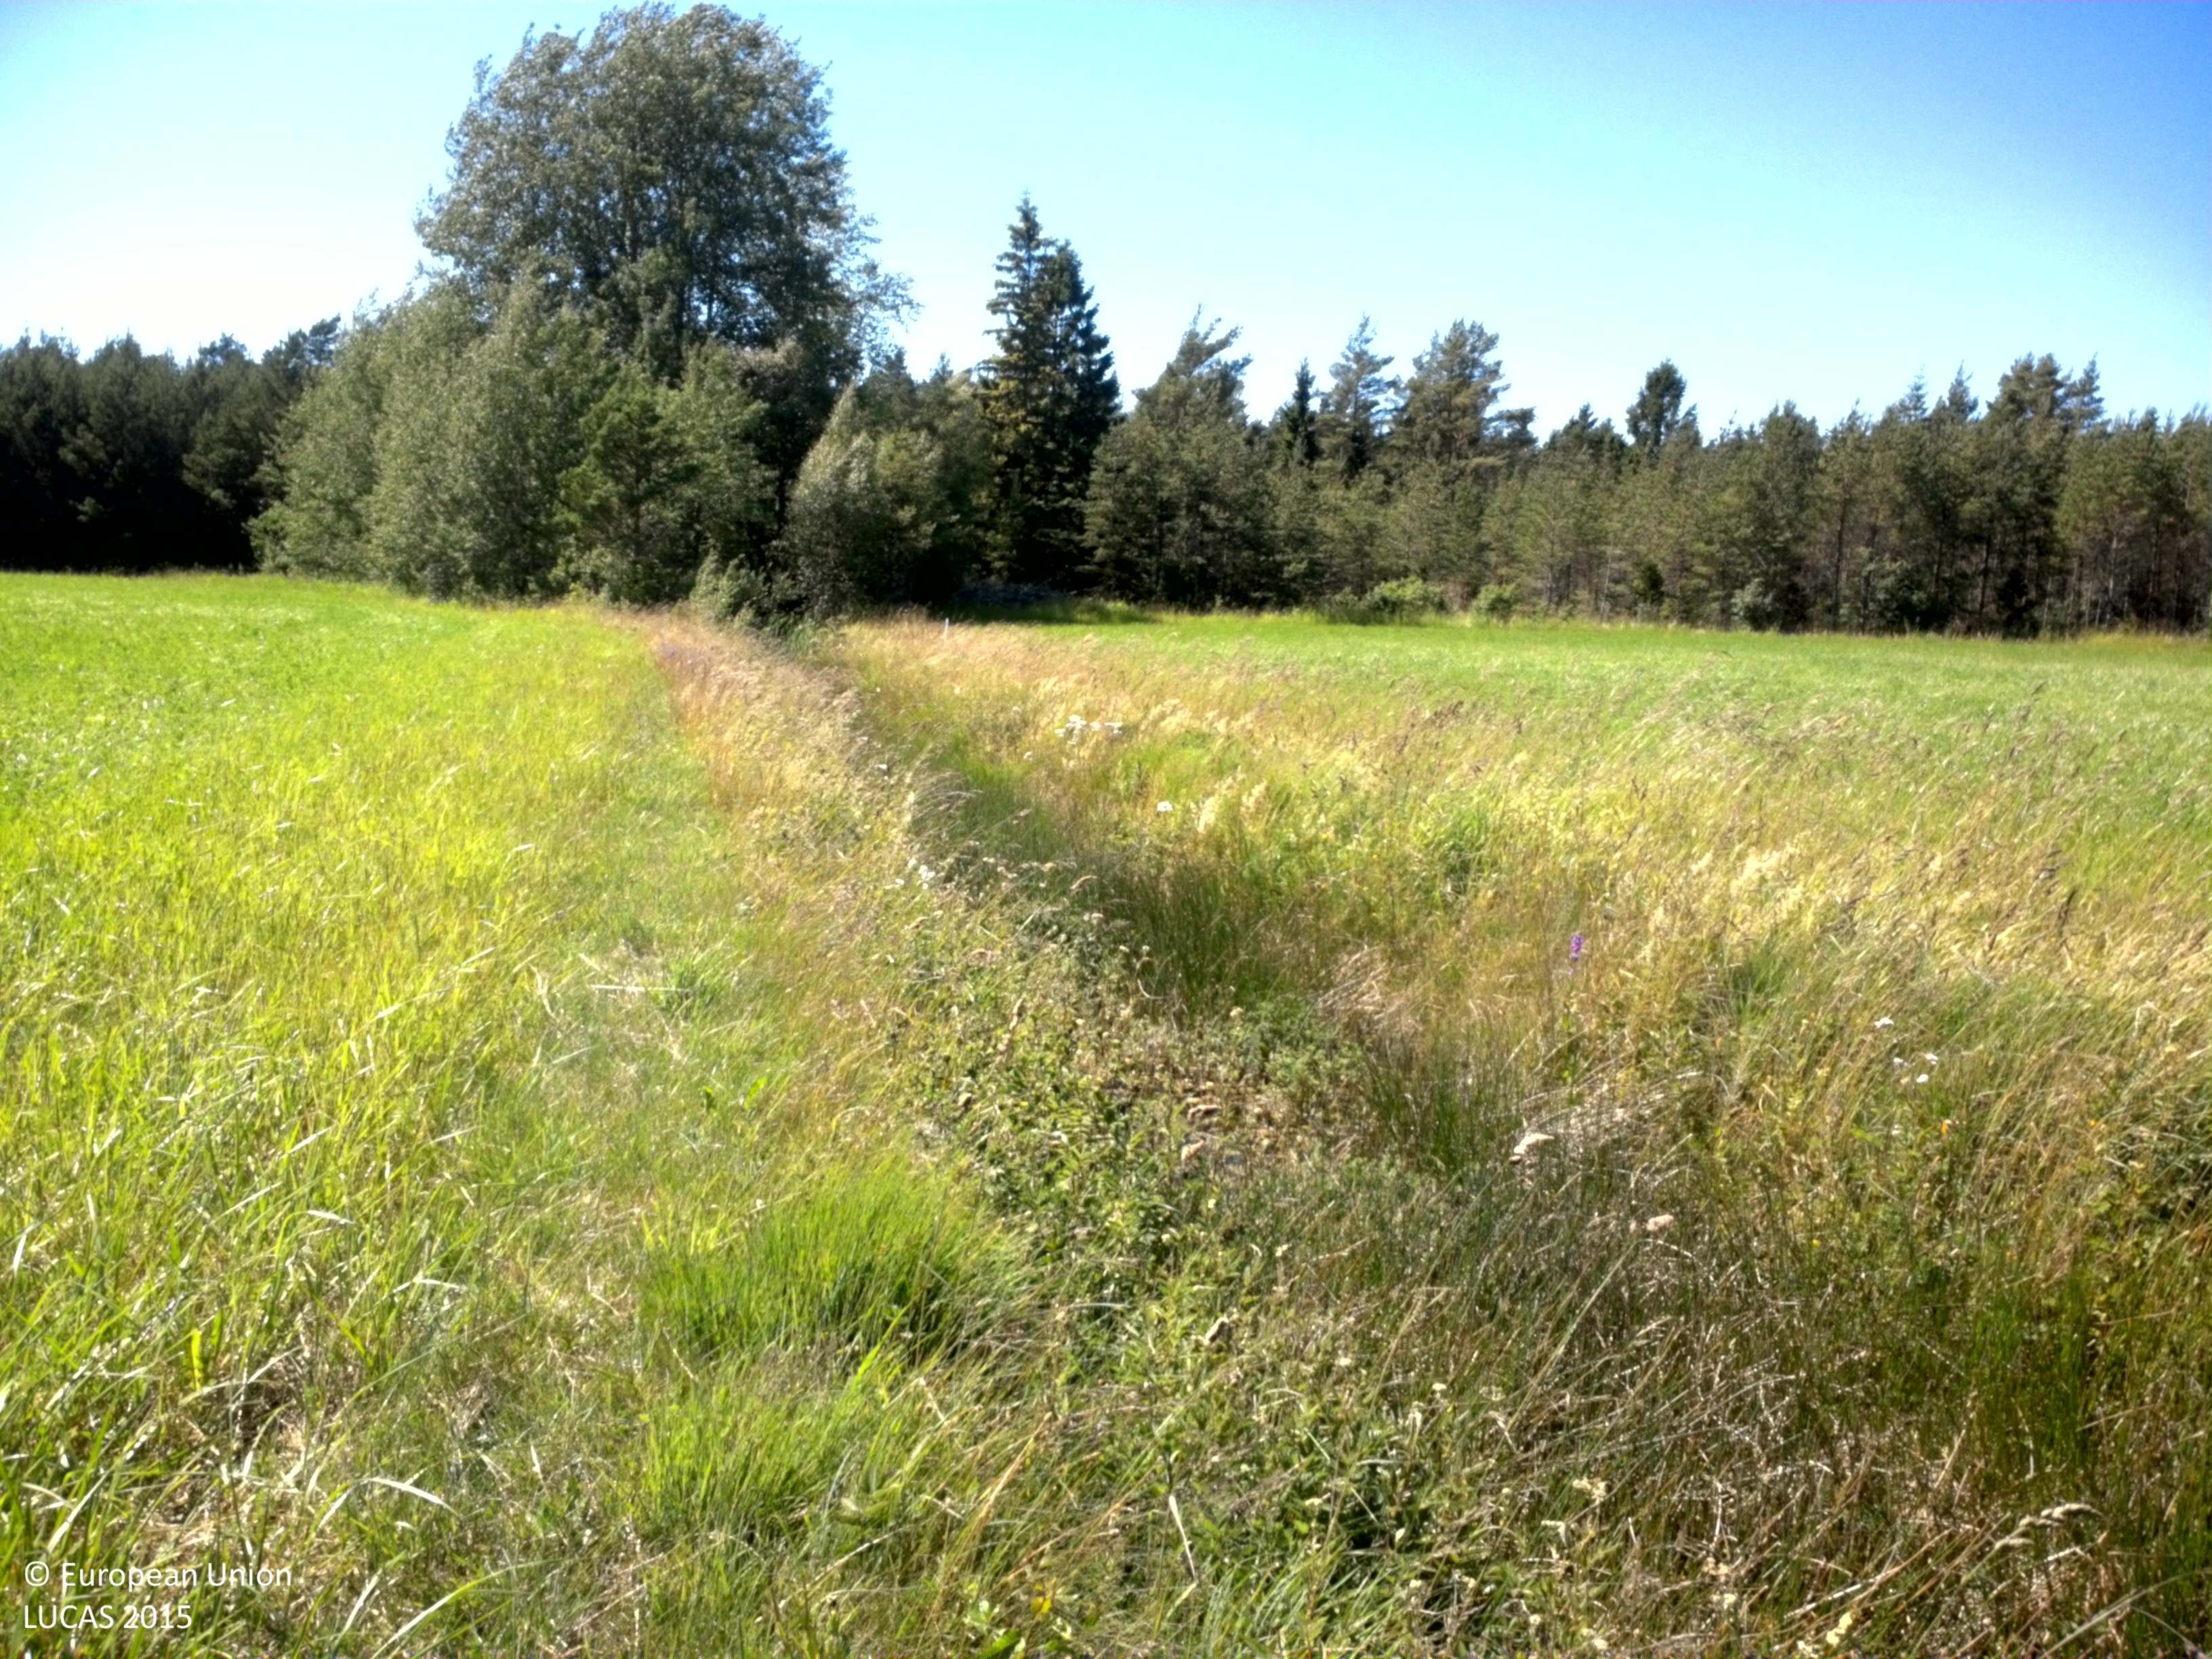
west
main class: Cropland
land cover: Lucerne
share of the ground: > 75 %
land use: Agriculture (excluding fallow land and kitchen gardens)
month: July
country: SE
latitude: 57.8075
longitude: 18.7434
